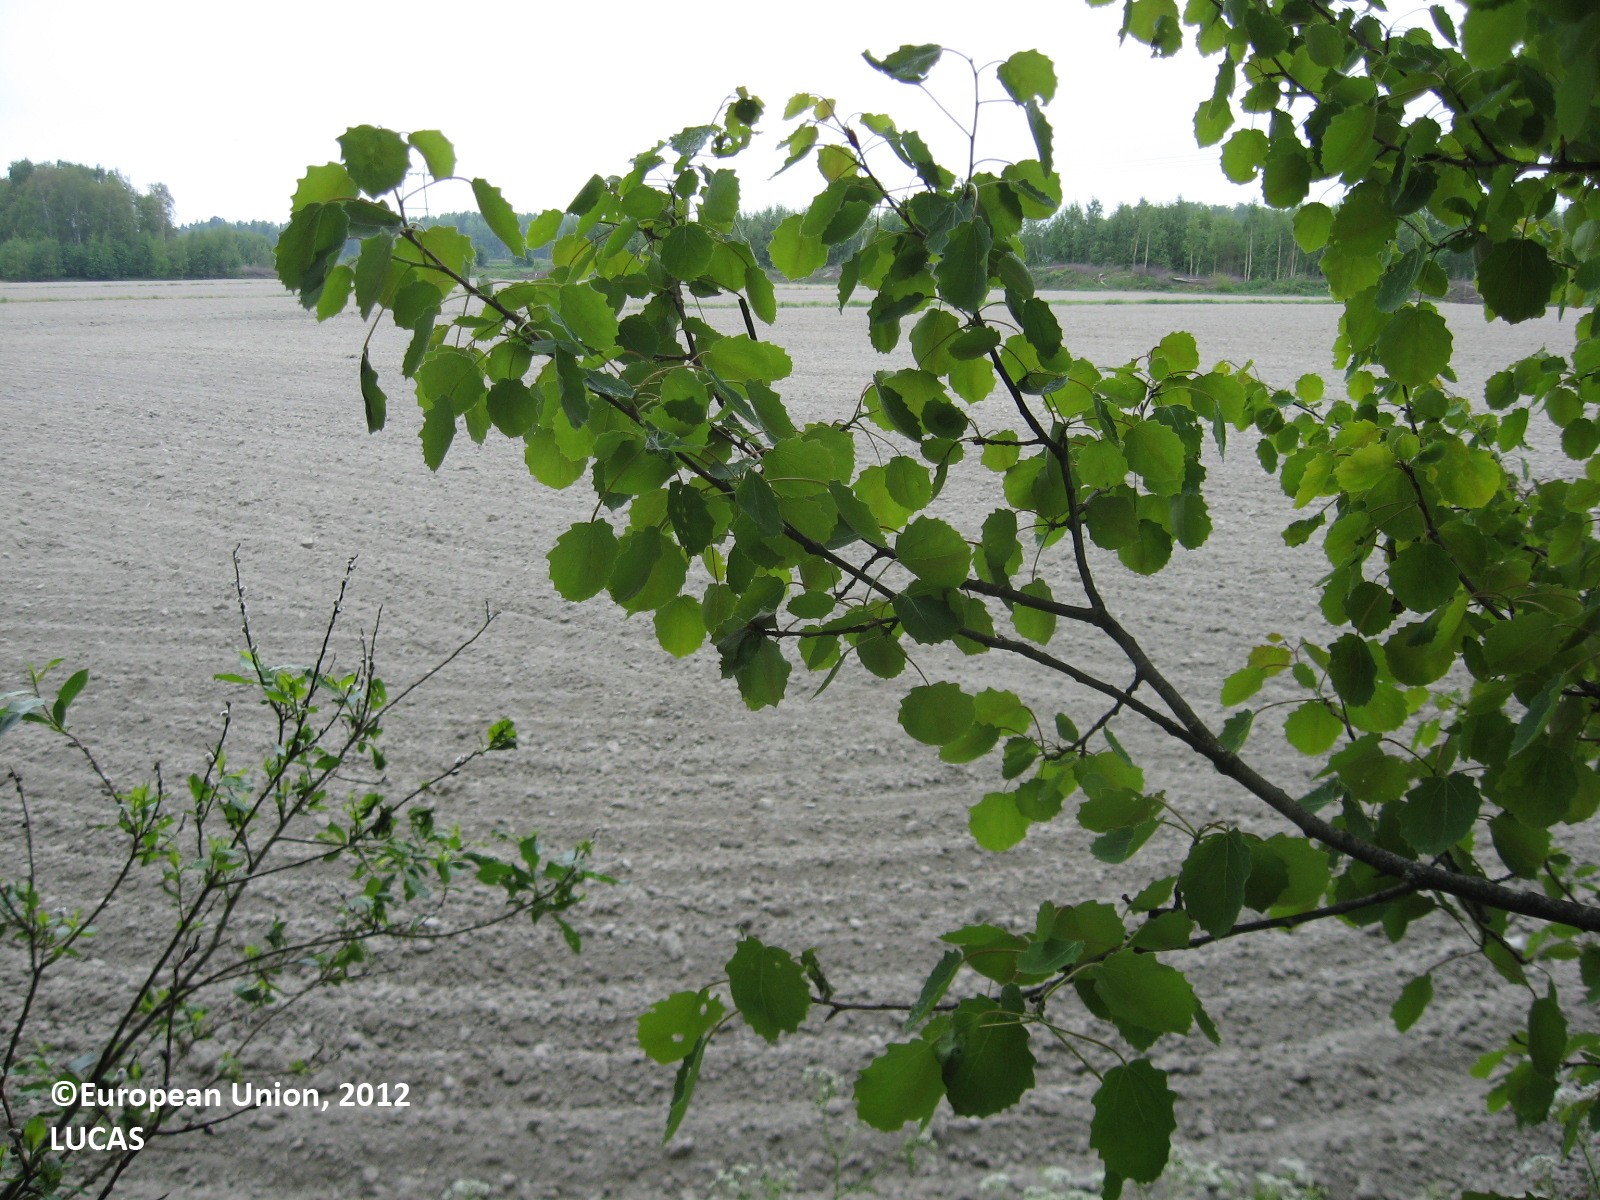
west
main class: Woodland
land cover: Broadleaved woodland
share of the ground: > 75 %
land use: Forestry
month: June
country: FI
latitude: 63.1037
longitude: 21.7114
